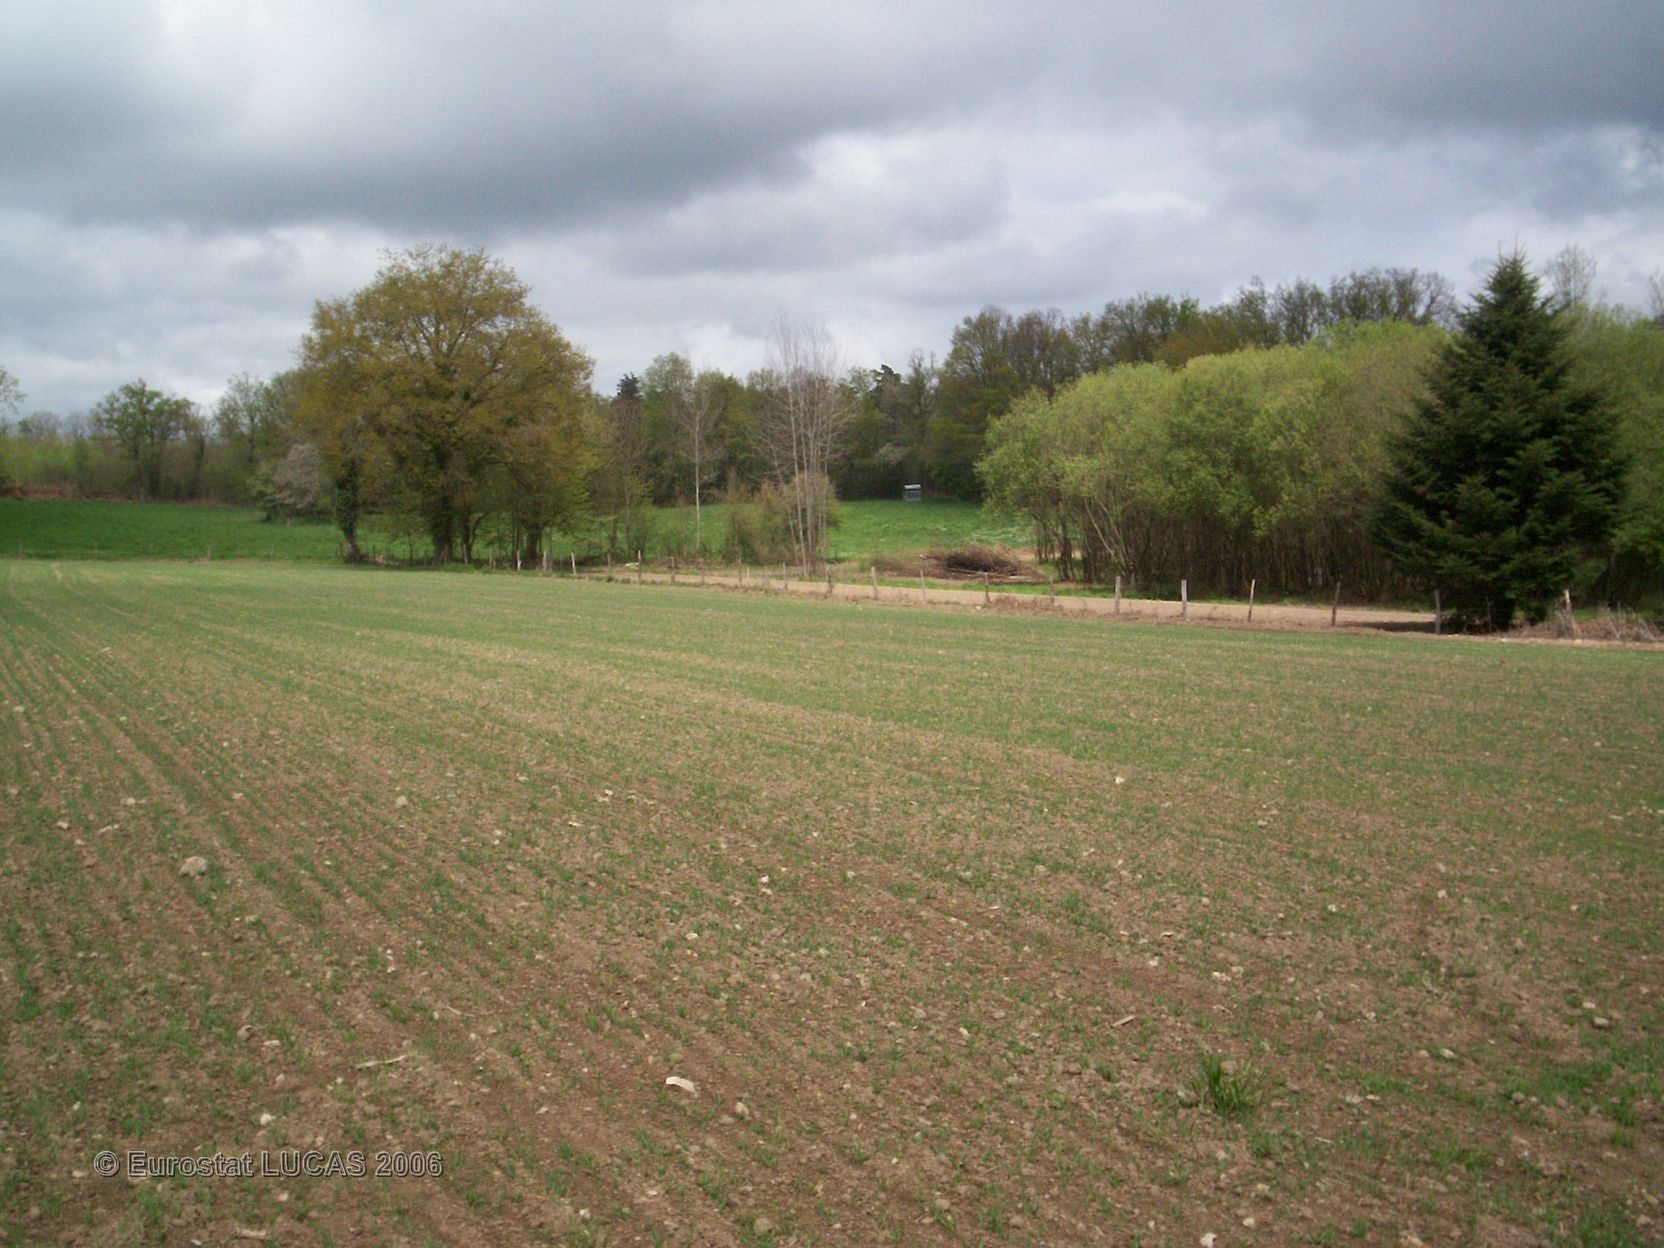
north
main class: Cropland
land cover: Common wheat
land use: Agriculture (excluding fallow land and kitchen gardens)
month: April
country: FR
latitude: 45.7476
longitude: 0.7197
